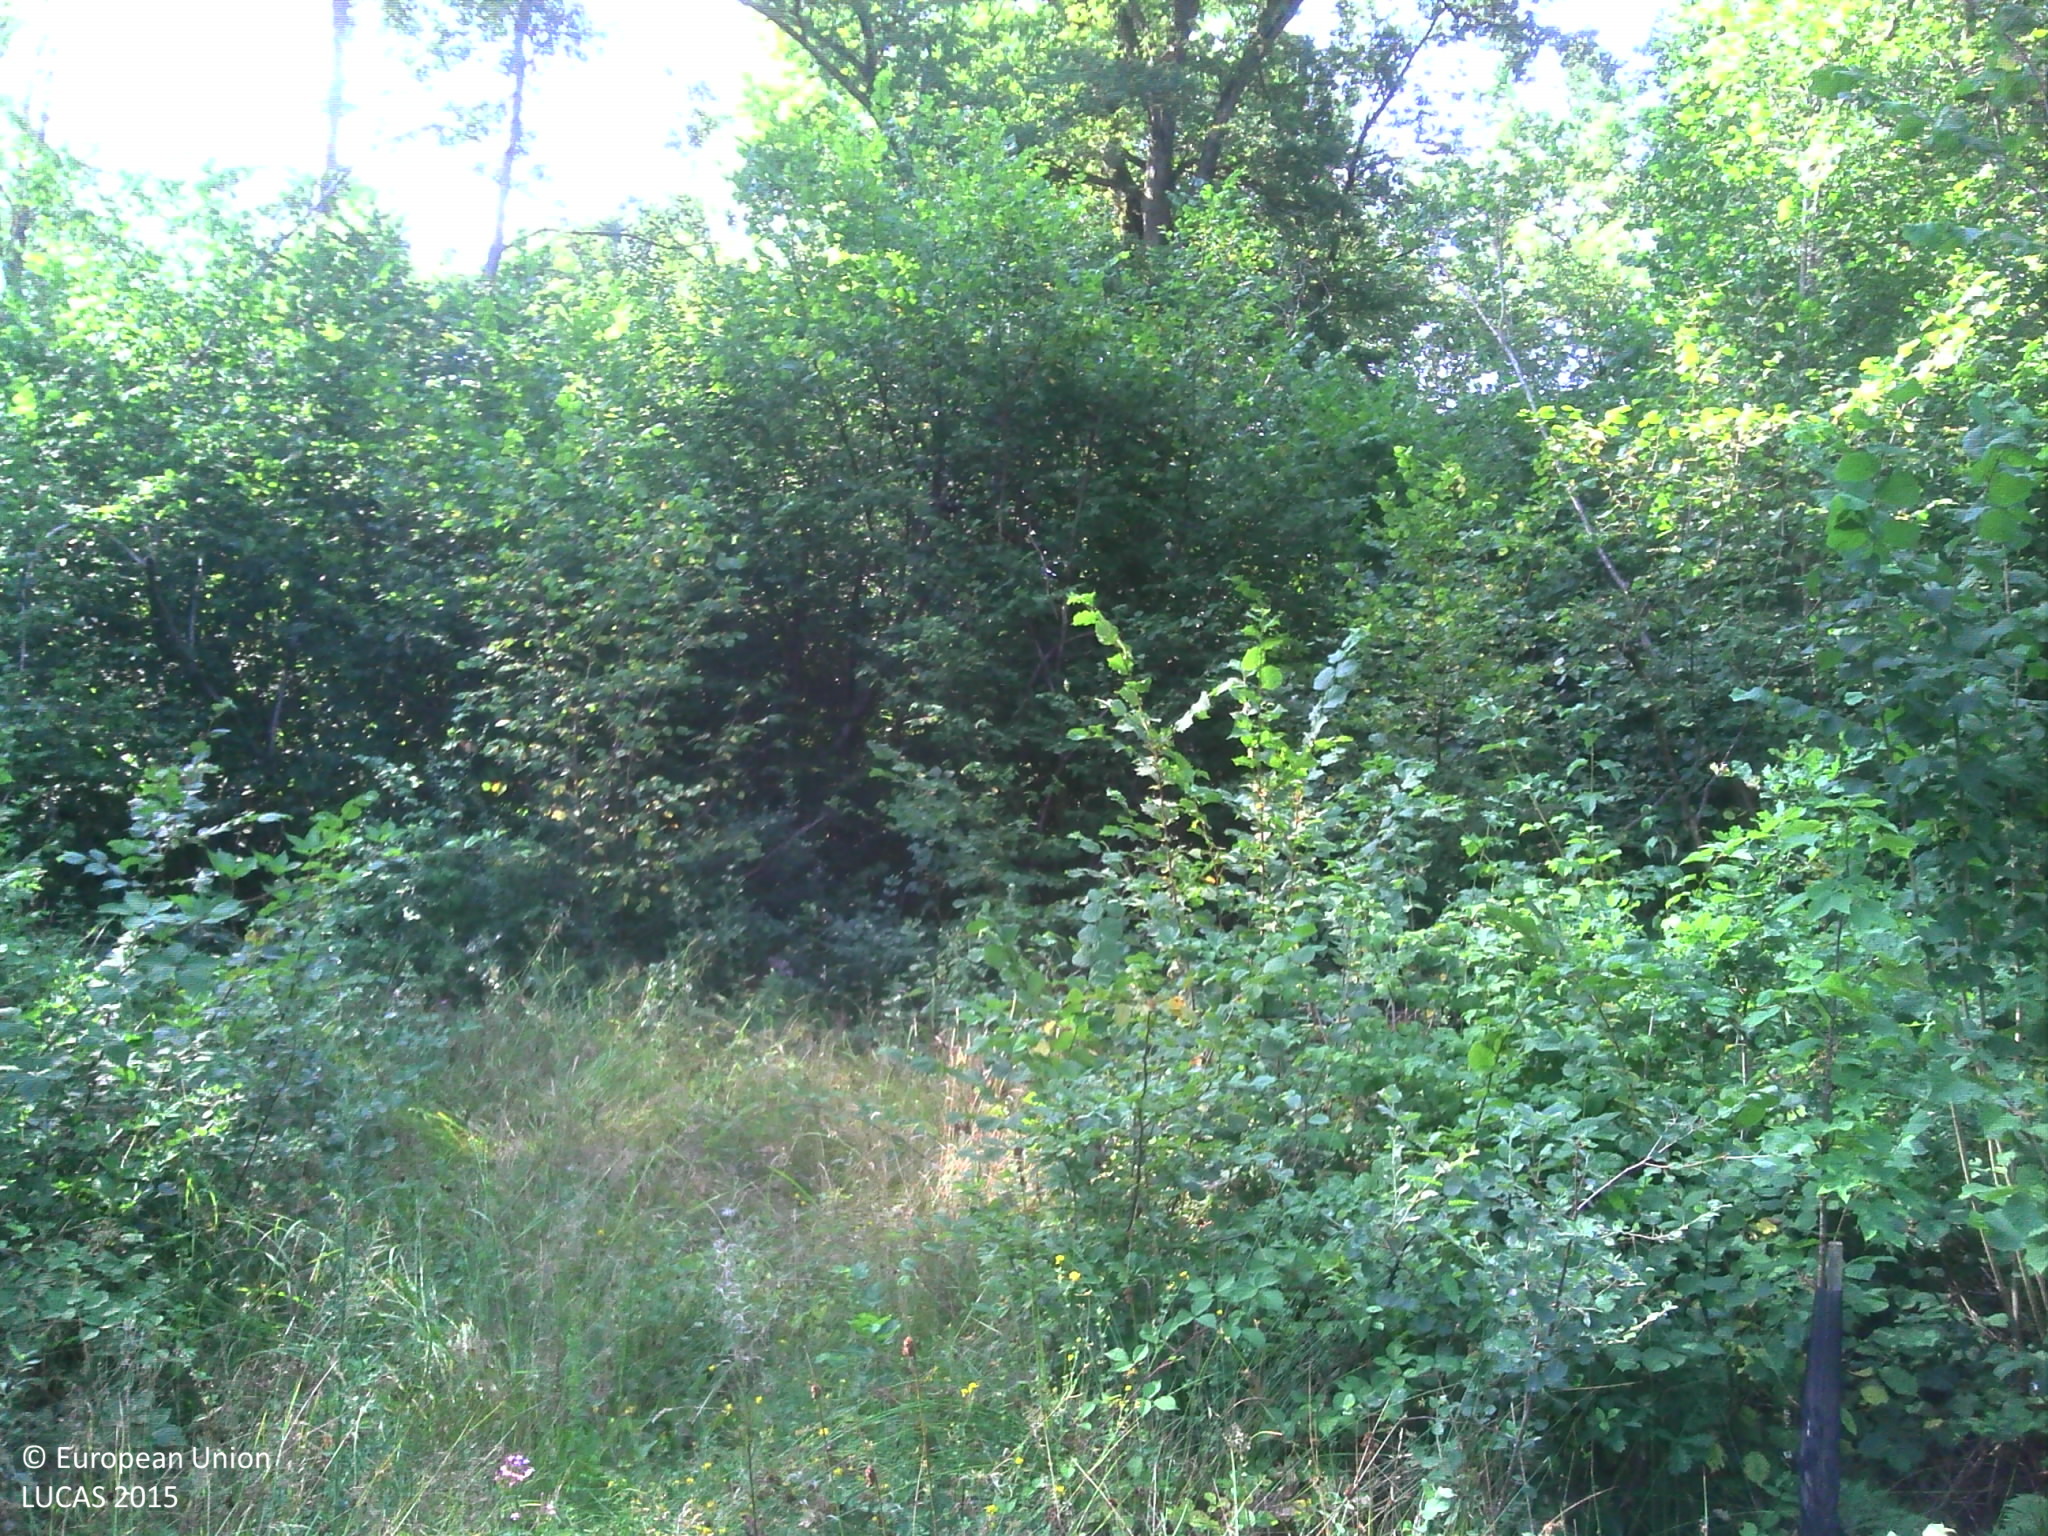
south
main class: Woodland
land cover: Broadleaved woodland
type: mesophytic deciduous forest
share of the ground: > 75 %
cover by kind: broadleaved forest trees 80 %, herbaceous plants 20 %
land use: Forestry
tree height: > 5 m
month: July
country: FR
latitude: 46.8540
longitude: 5.1357
